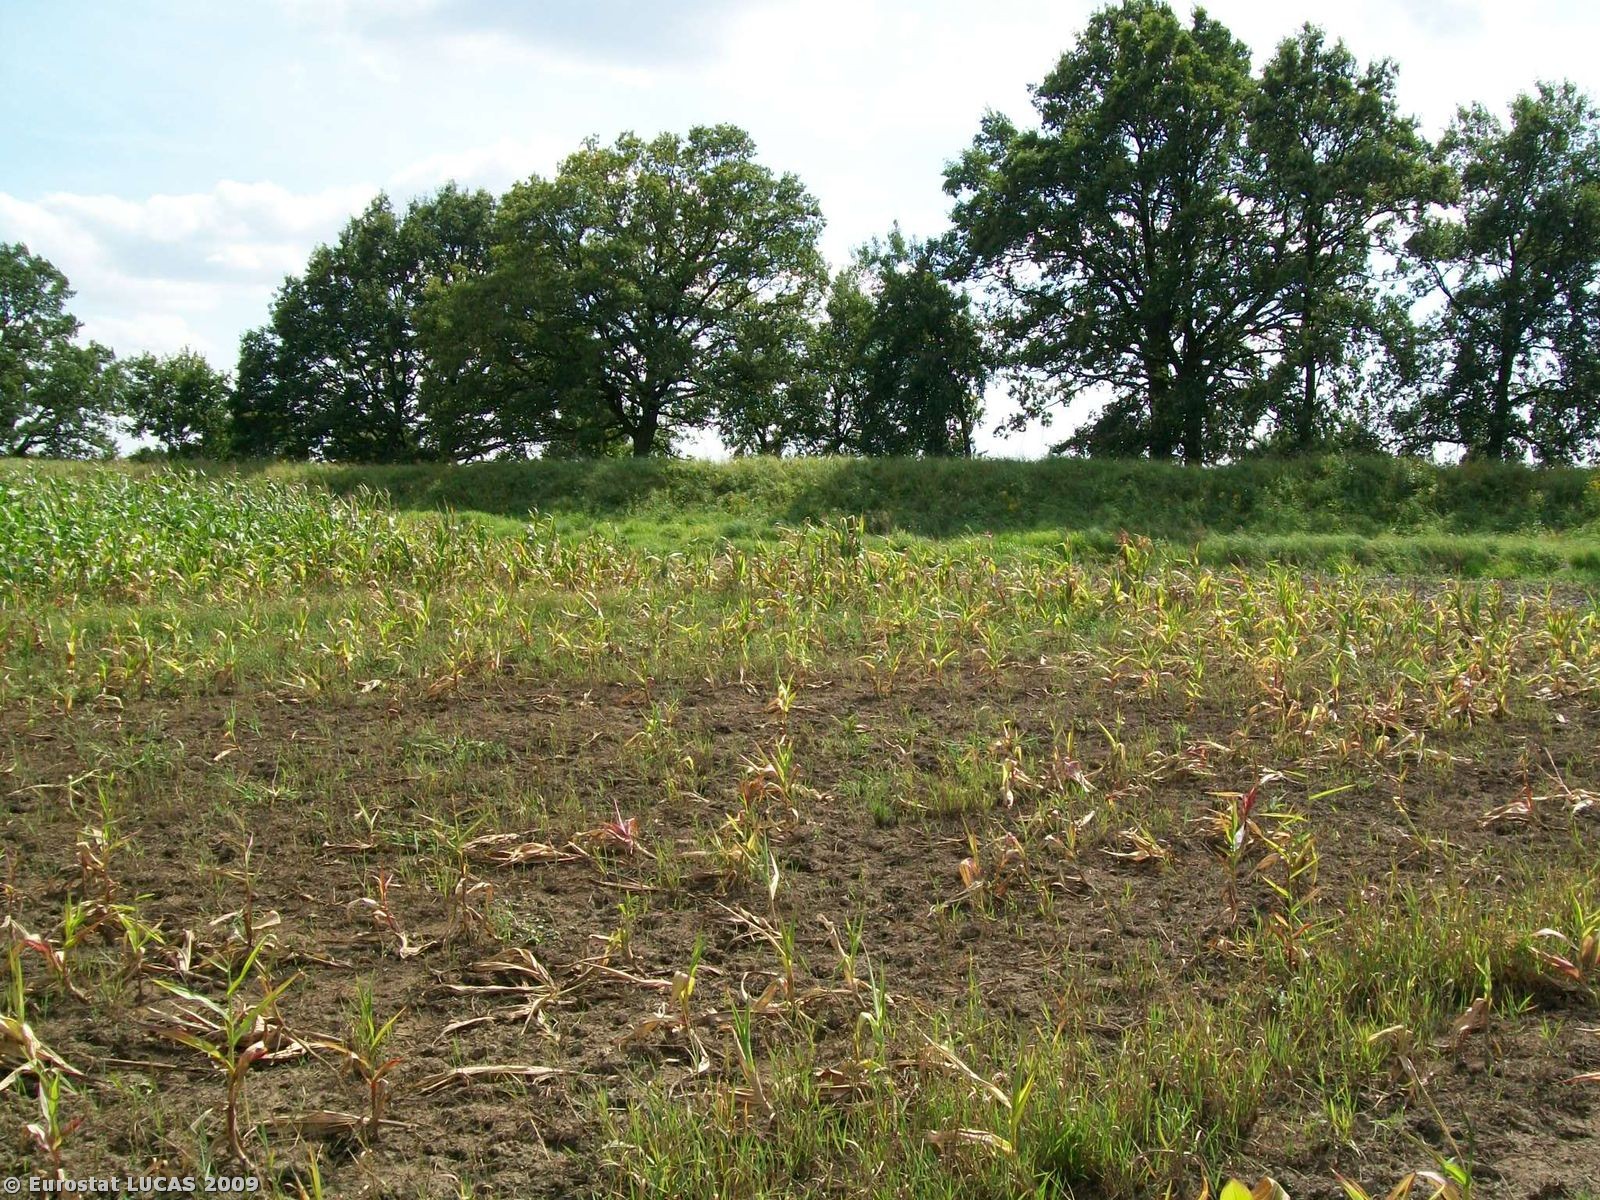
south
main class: Cropland
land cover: Maize
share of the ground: 50 - 75 %
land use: Agriculture (excluding fallow land and kitchen gardens)
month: August
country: PL
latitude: 51.0174
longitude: 17.2673
